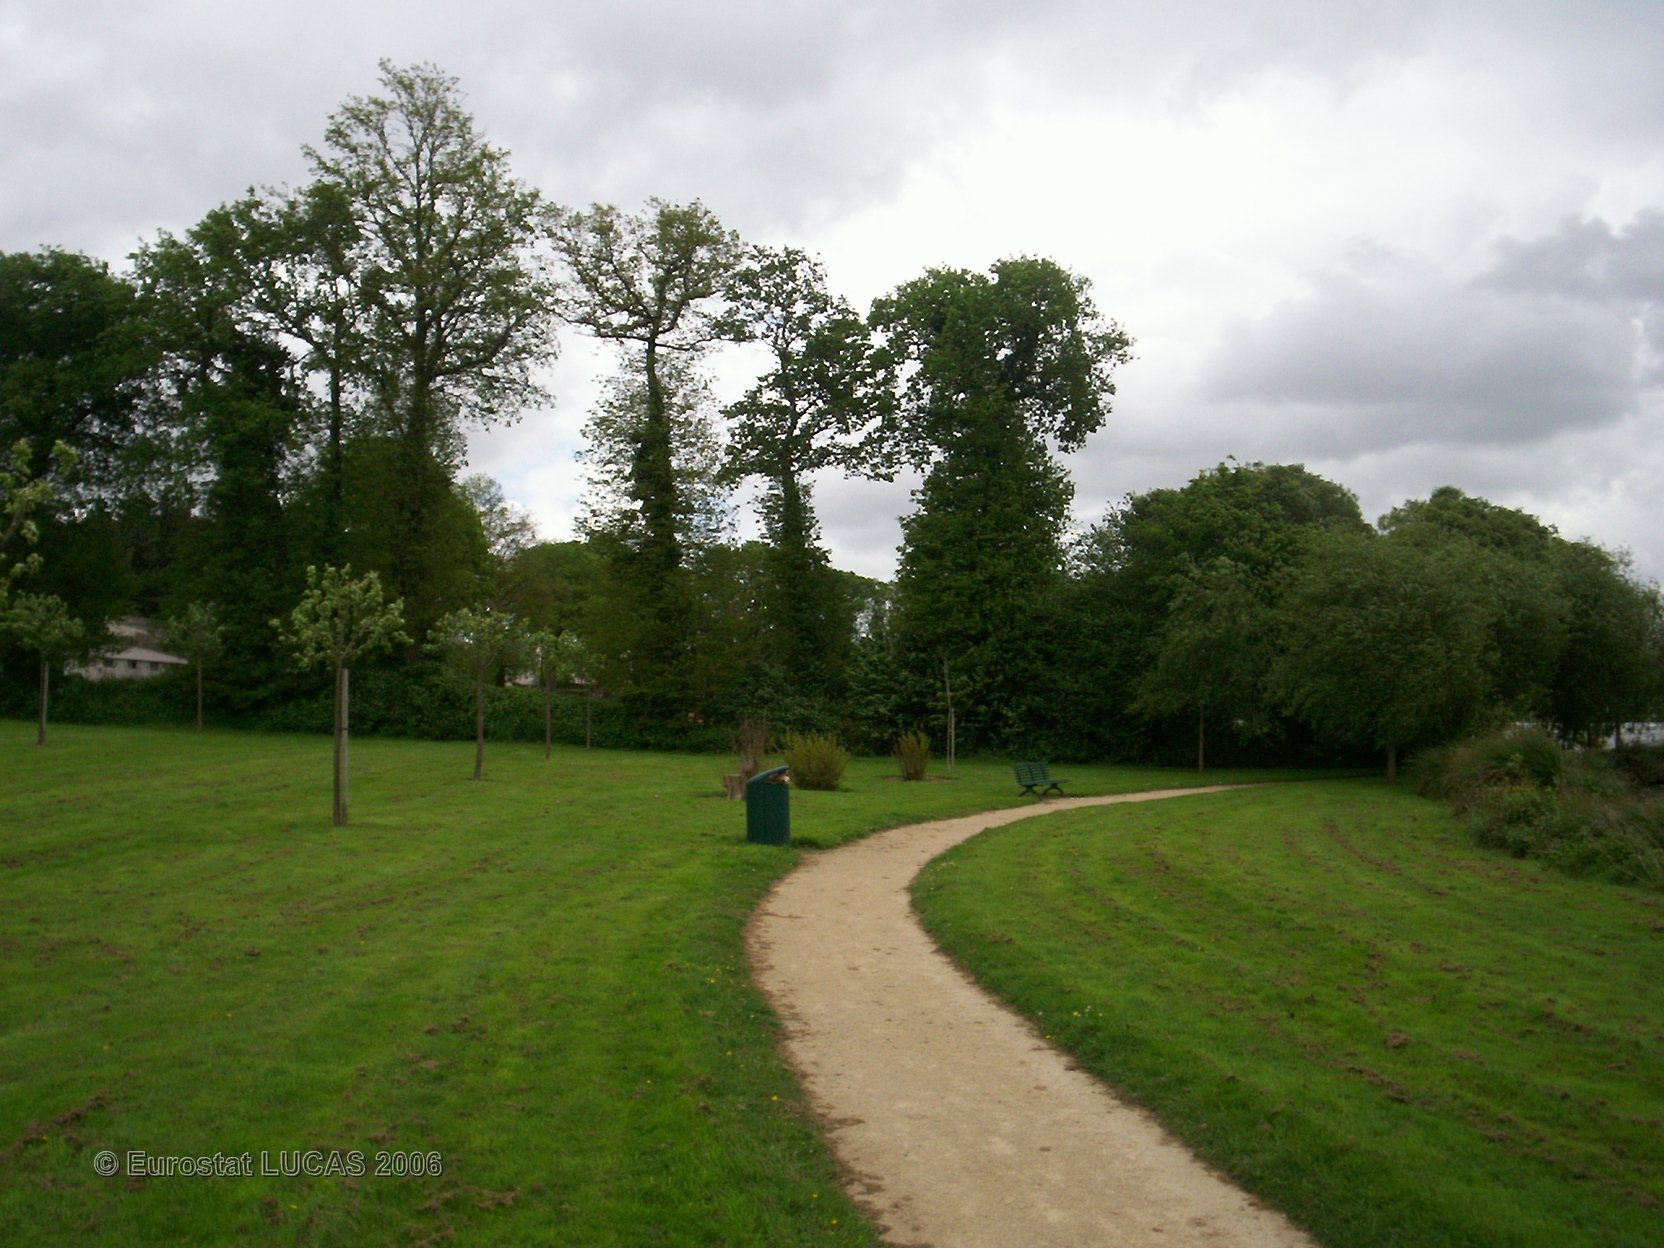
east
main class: Grassland
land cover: Grassland without tree/shrub cover
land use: Amenities, museums, leisure
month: May
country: FR
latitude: 47.9716
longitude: -2.7487
